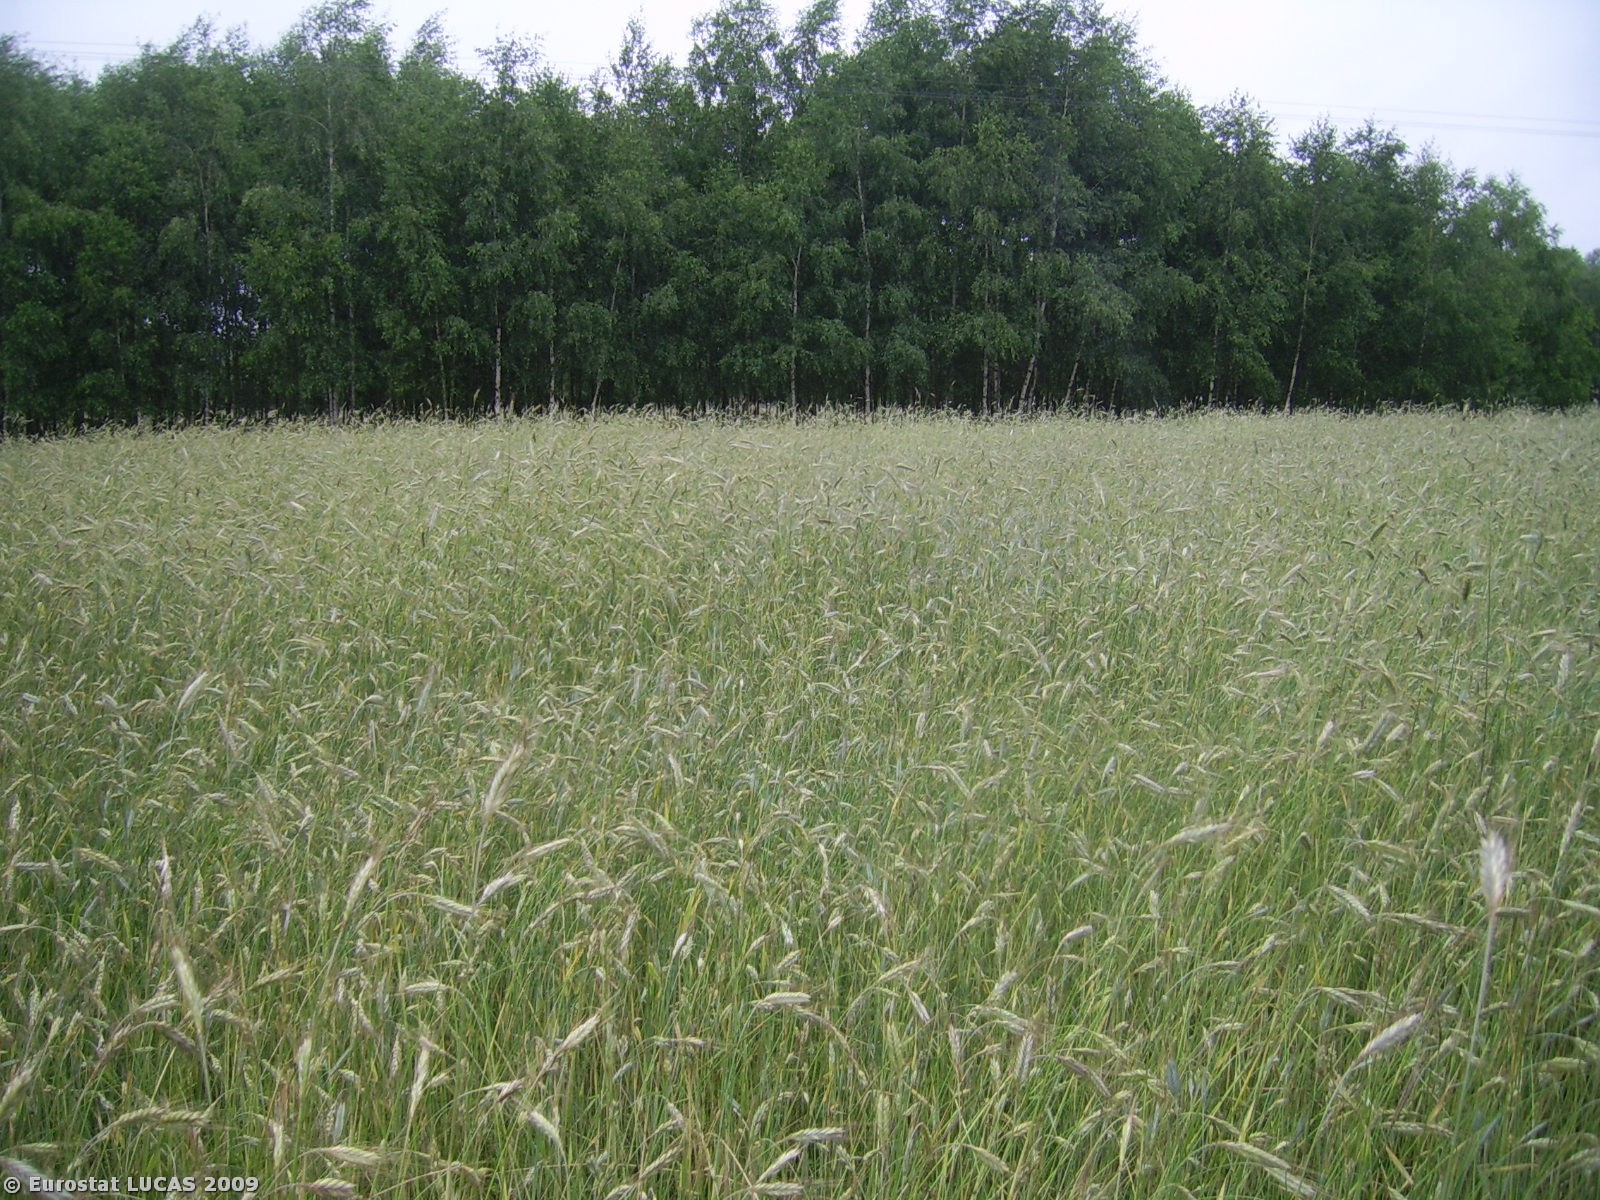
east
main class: Cropland
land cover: Triticale
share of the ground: > 75 %
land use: Agriculture (excluding fallow land and kitchen gardens)
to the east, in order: Triticale; Grass margins; Paved roads, cycling and walking lanes; Rice; Broadleaved woodland; Paved roads, cycling and walking lanes; Grass margins; Triticale
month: June
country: PL
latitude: 51.5553
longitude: 18.3984
